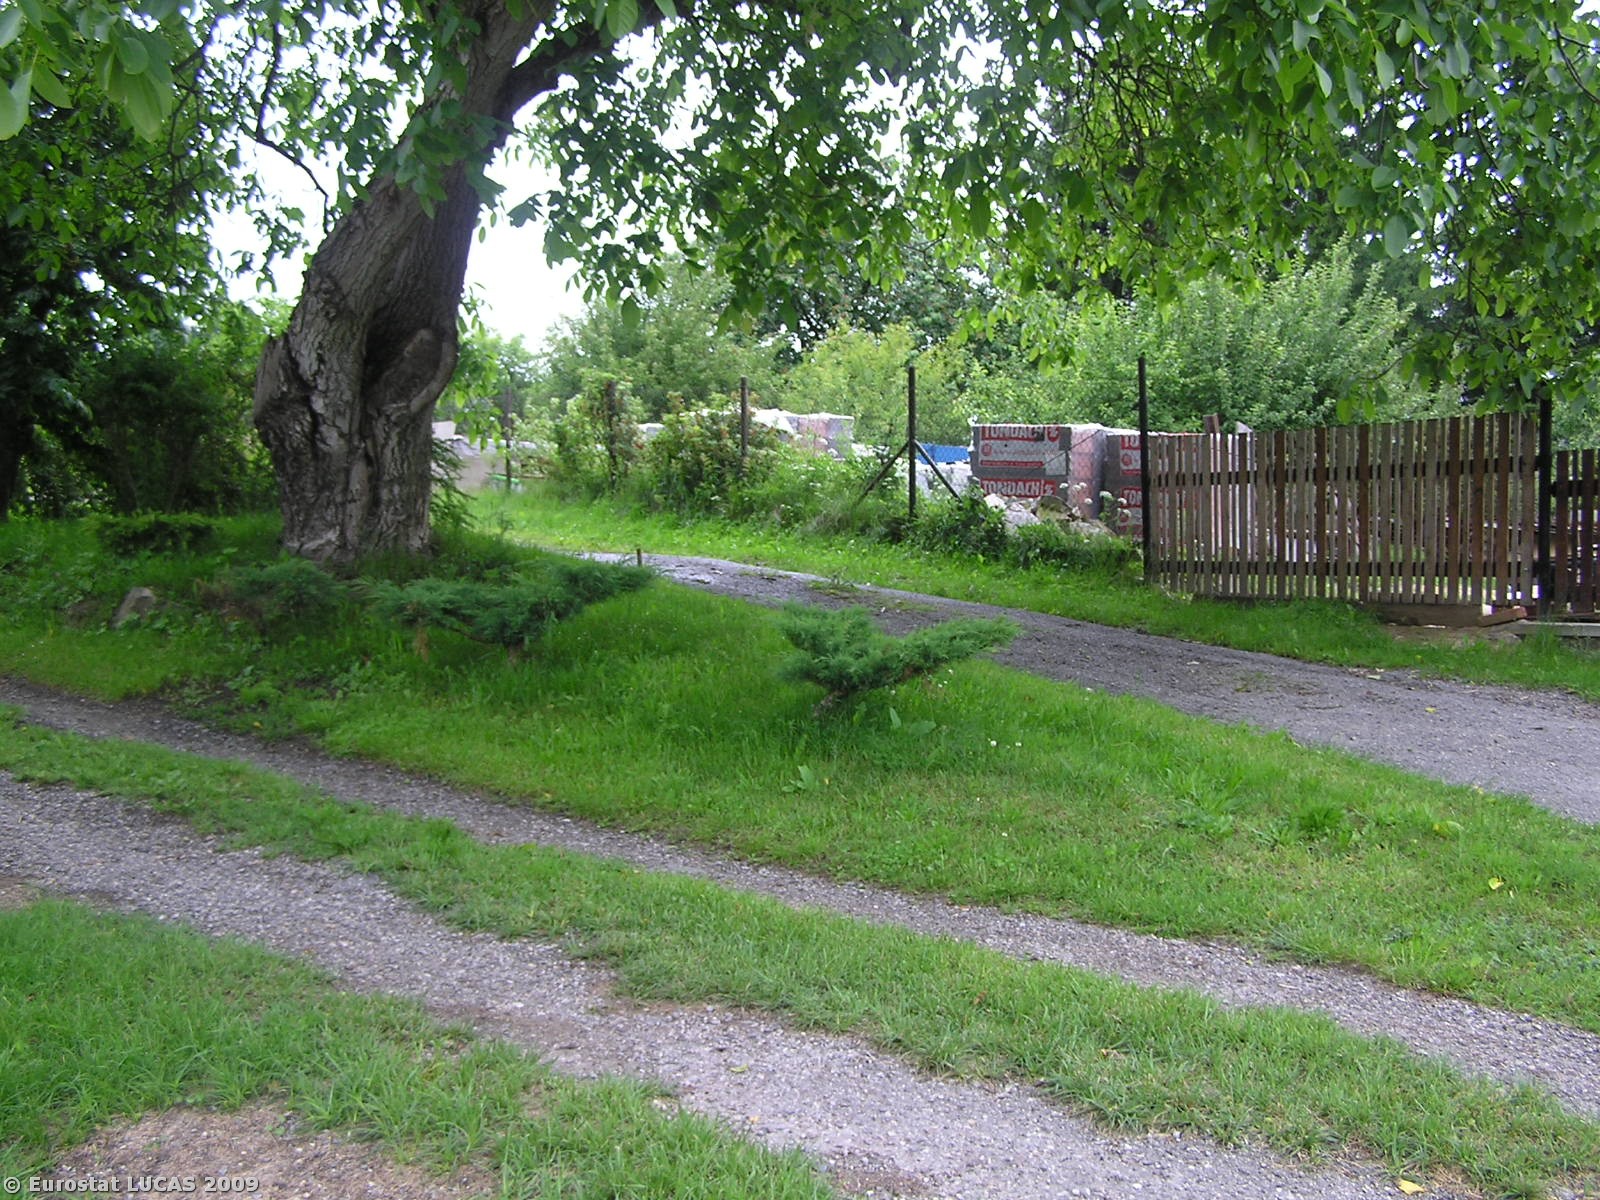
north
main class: Grassland
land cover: Grassland with sparse tree/shrub cover
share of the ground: > 75 %
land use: Residential
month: June
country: CZ
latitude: 49.1936
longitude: 14.9559
